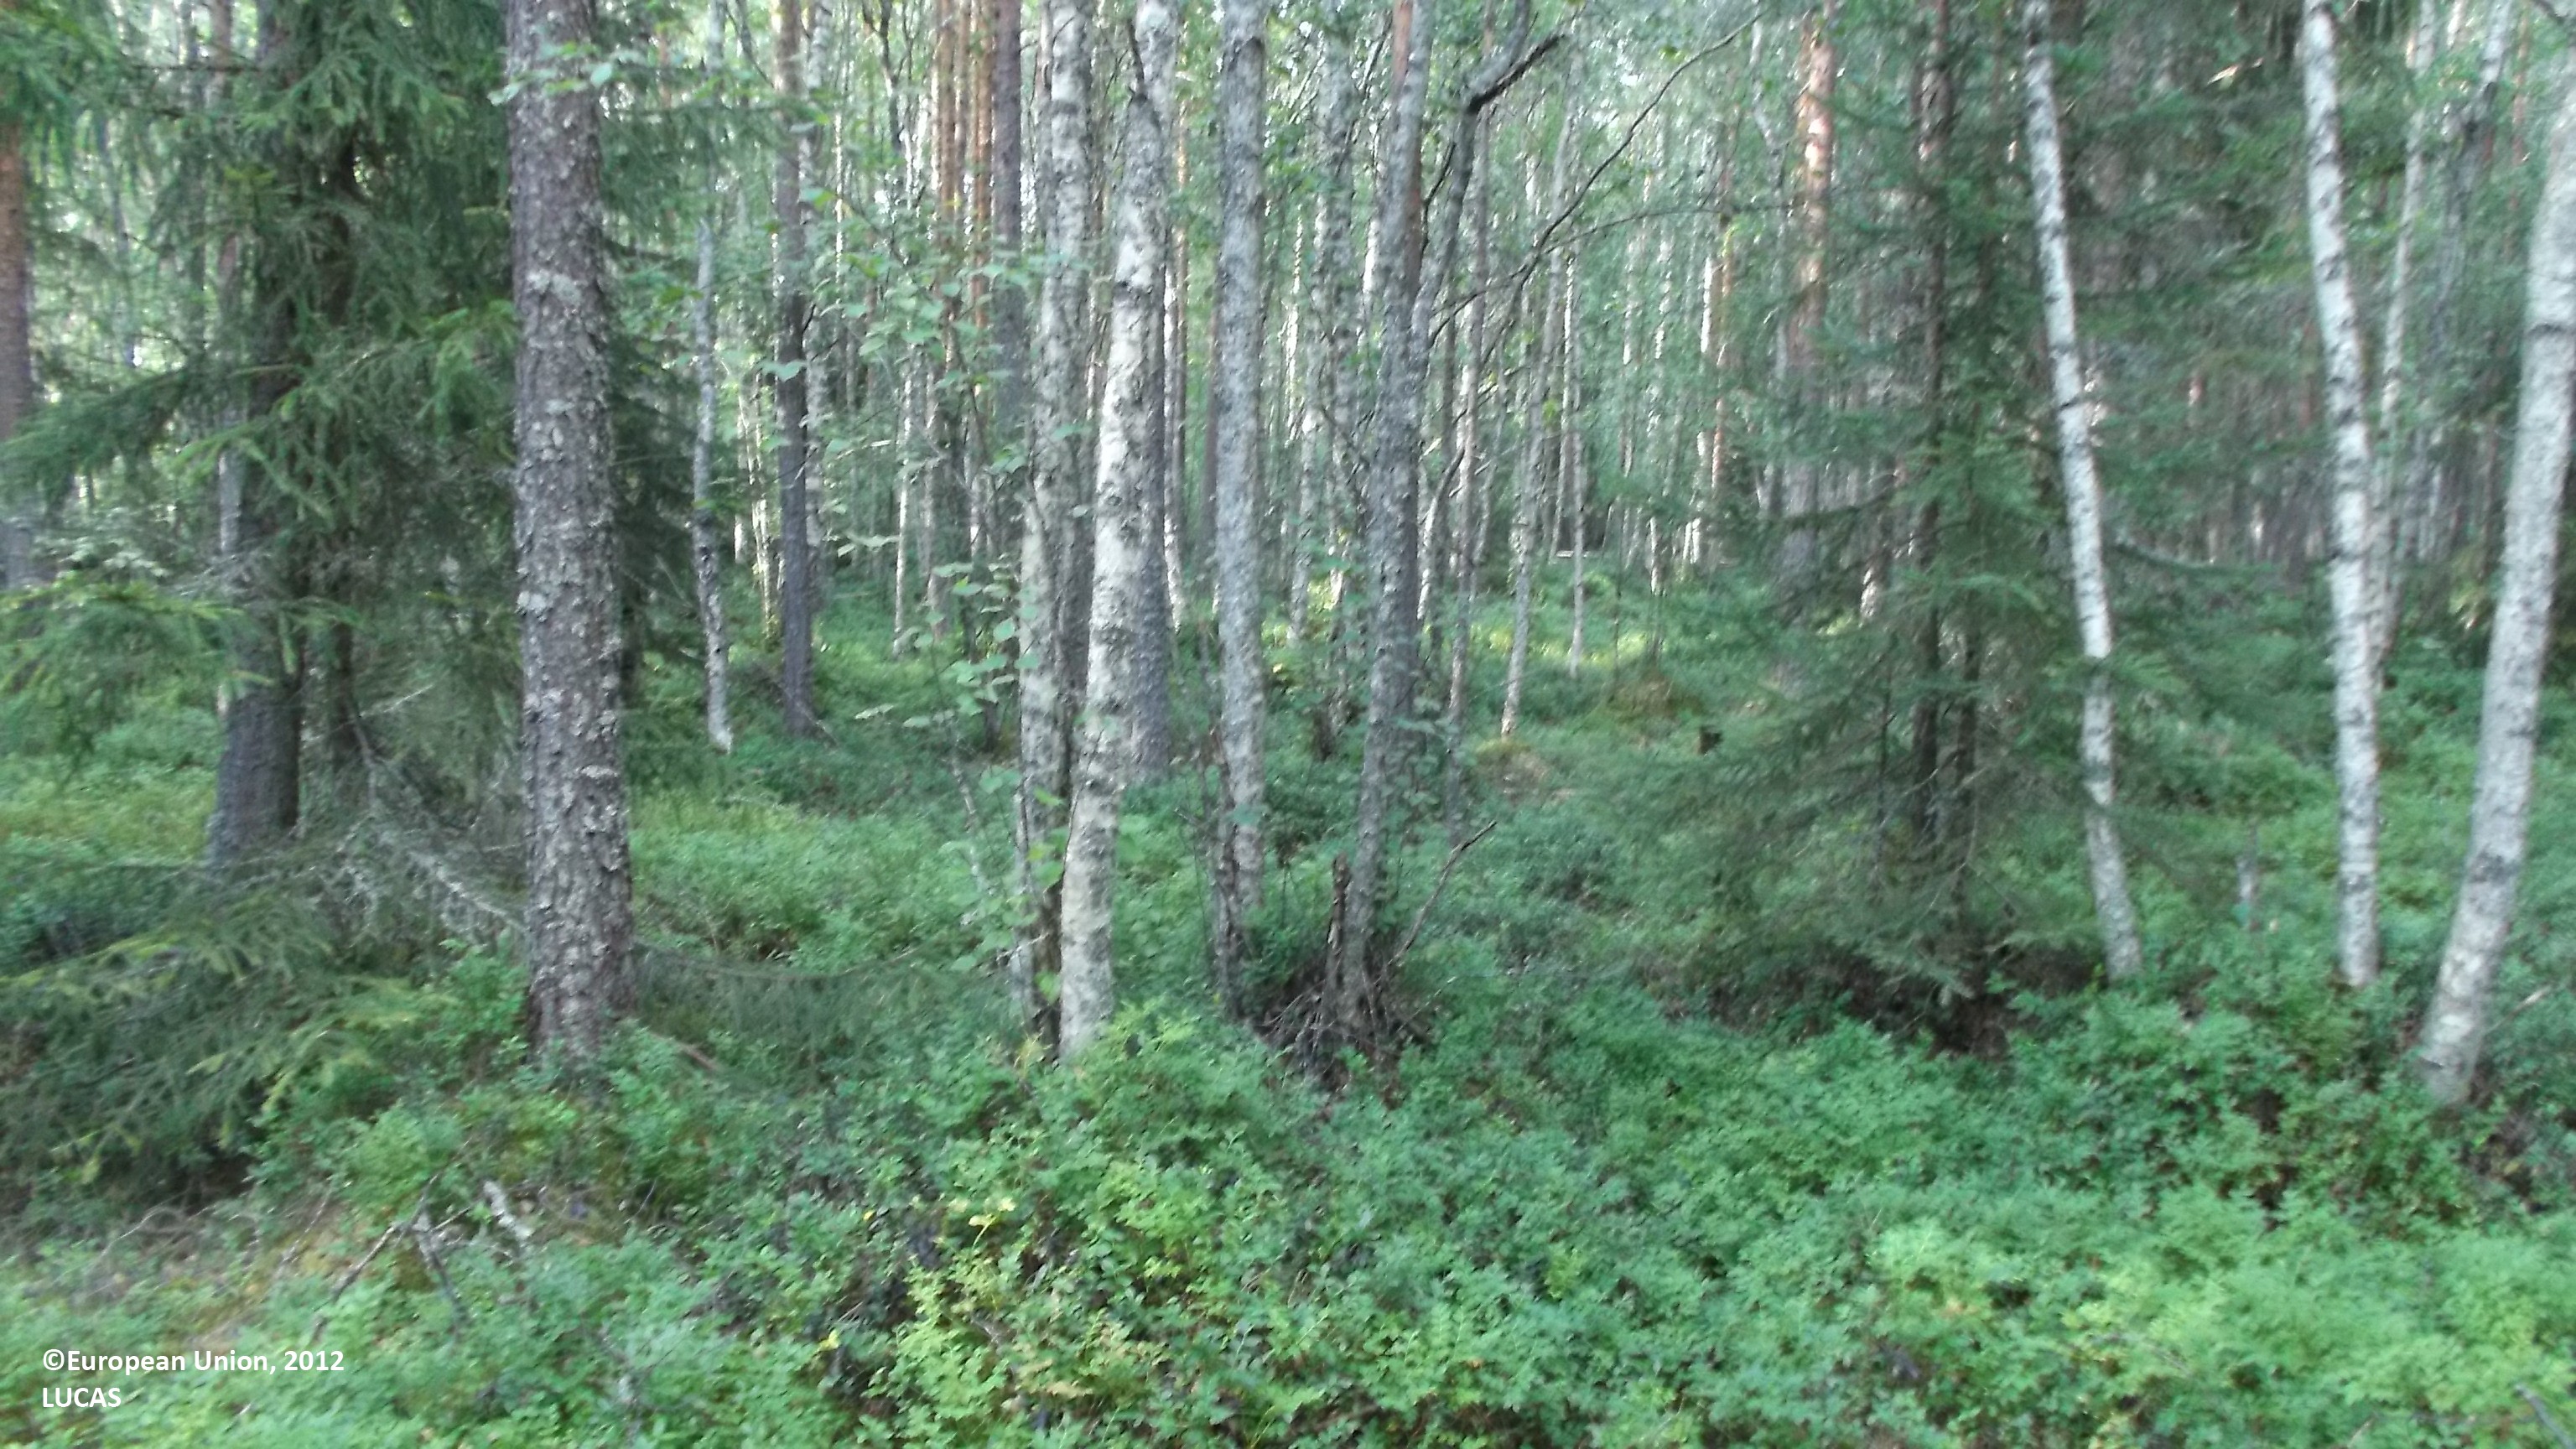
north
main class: Woodland
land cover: Other mixed woodland
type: boreal forest
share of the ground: 50 - 75 %
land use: Forestry
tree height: > 5 m
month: August
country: FI
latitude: 63.9499
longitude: 23.6733
